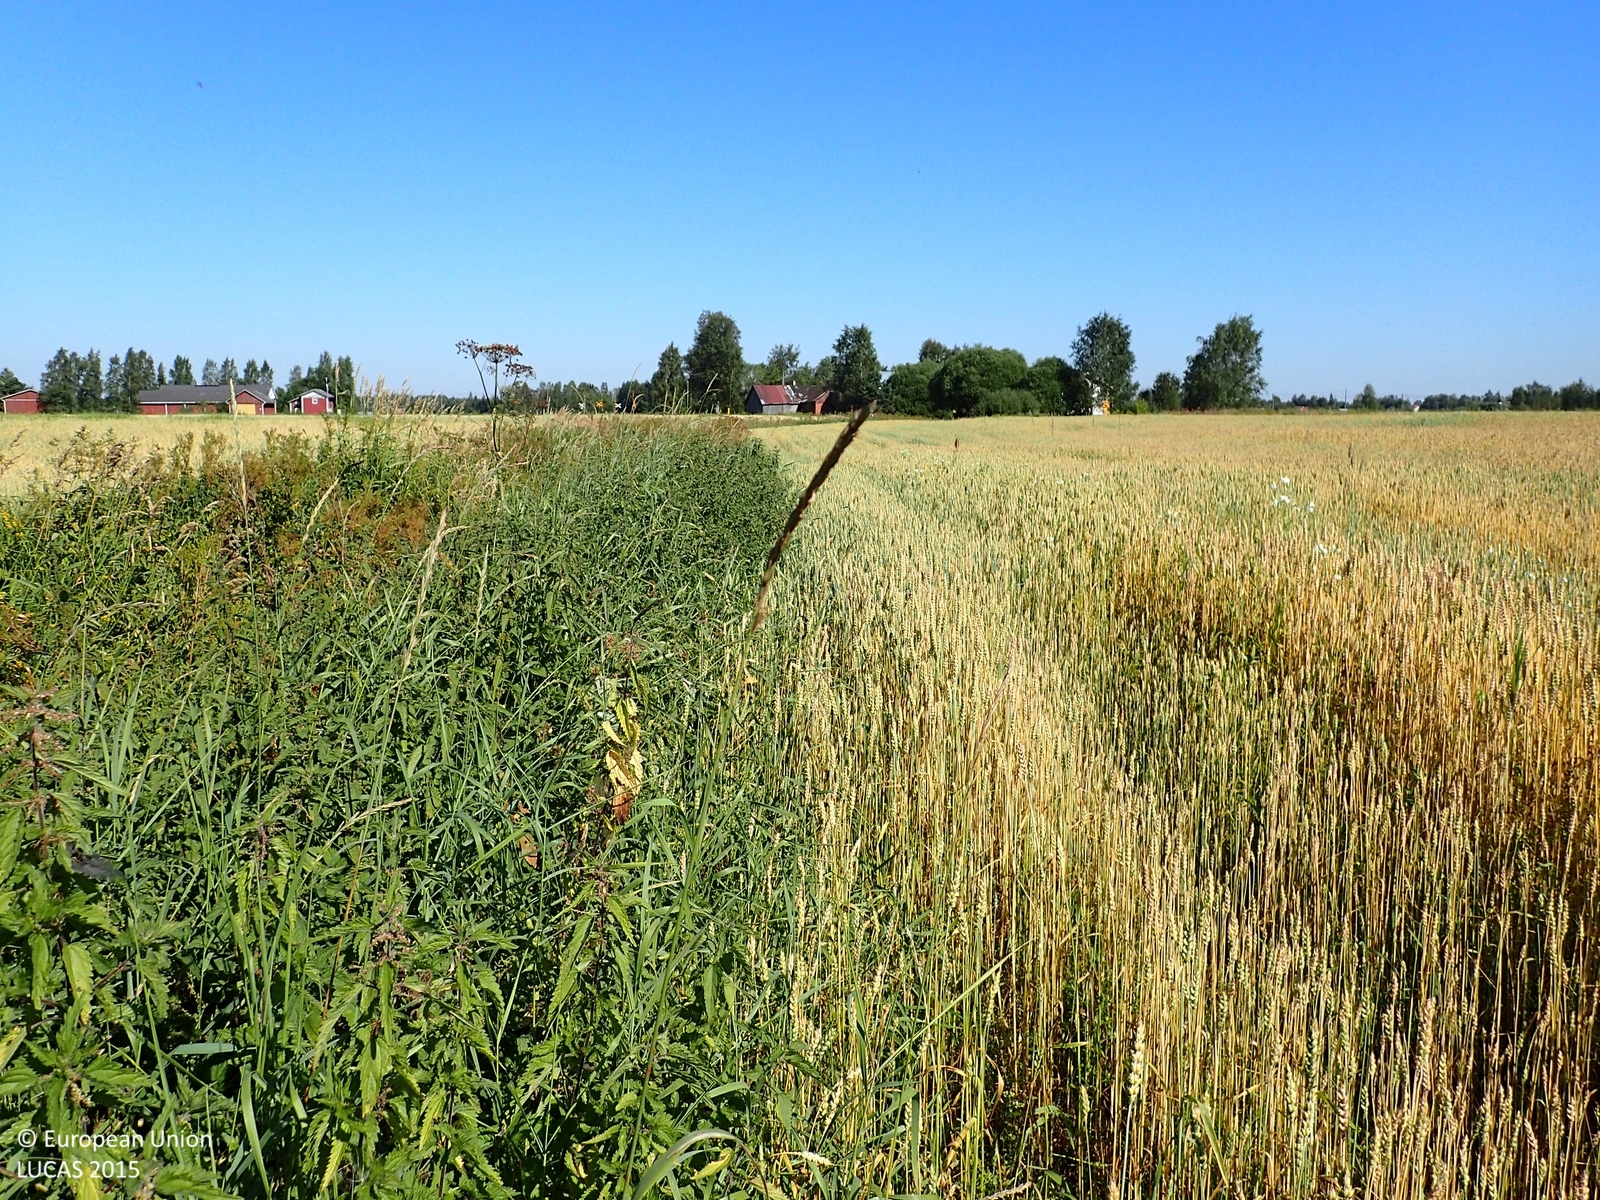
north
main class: Cropland
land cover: Common wheat
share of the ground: > 75 %
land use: Agriculture (excluding fallow land and kitchen gardens)
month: August
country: FI
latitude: 62.4652
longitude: 21.6992
